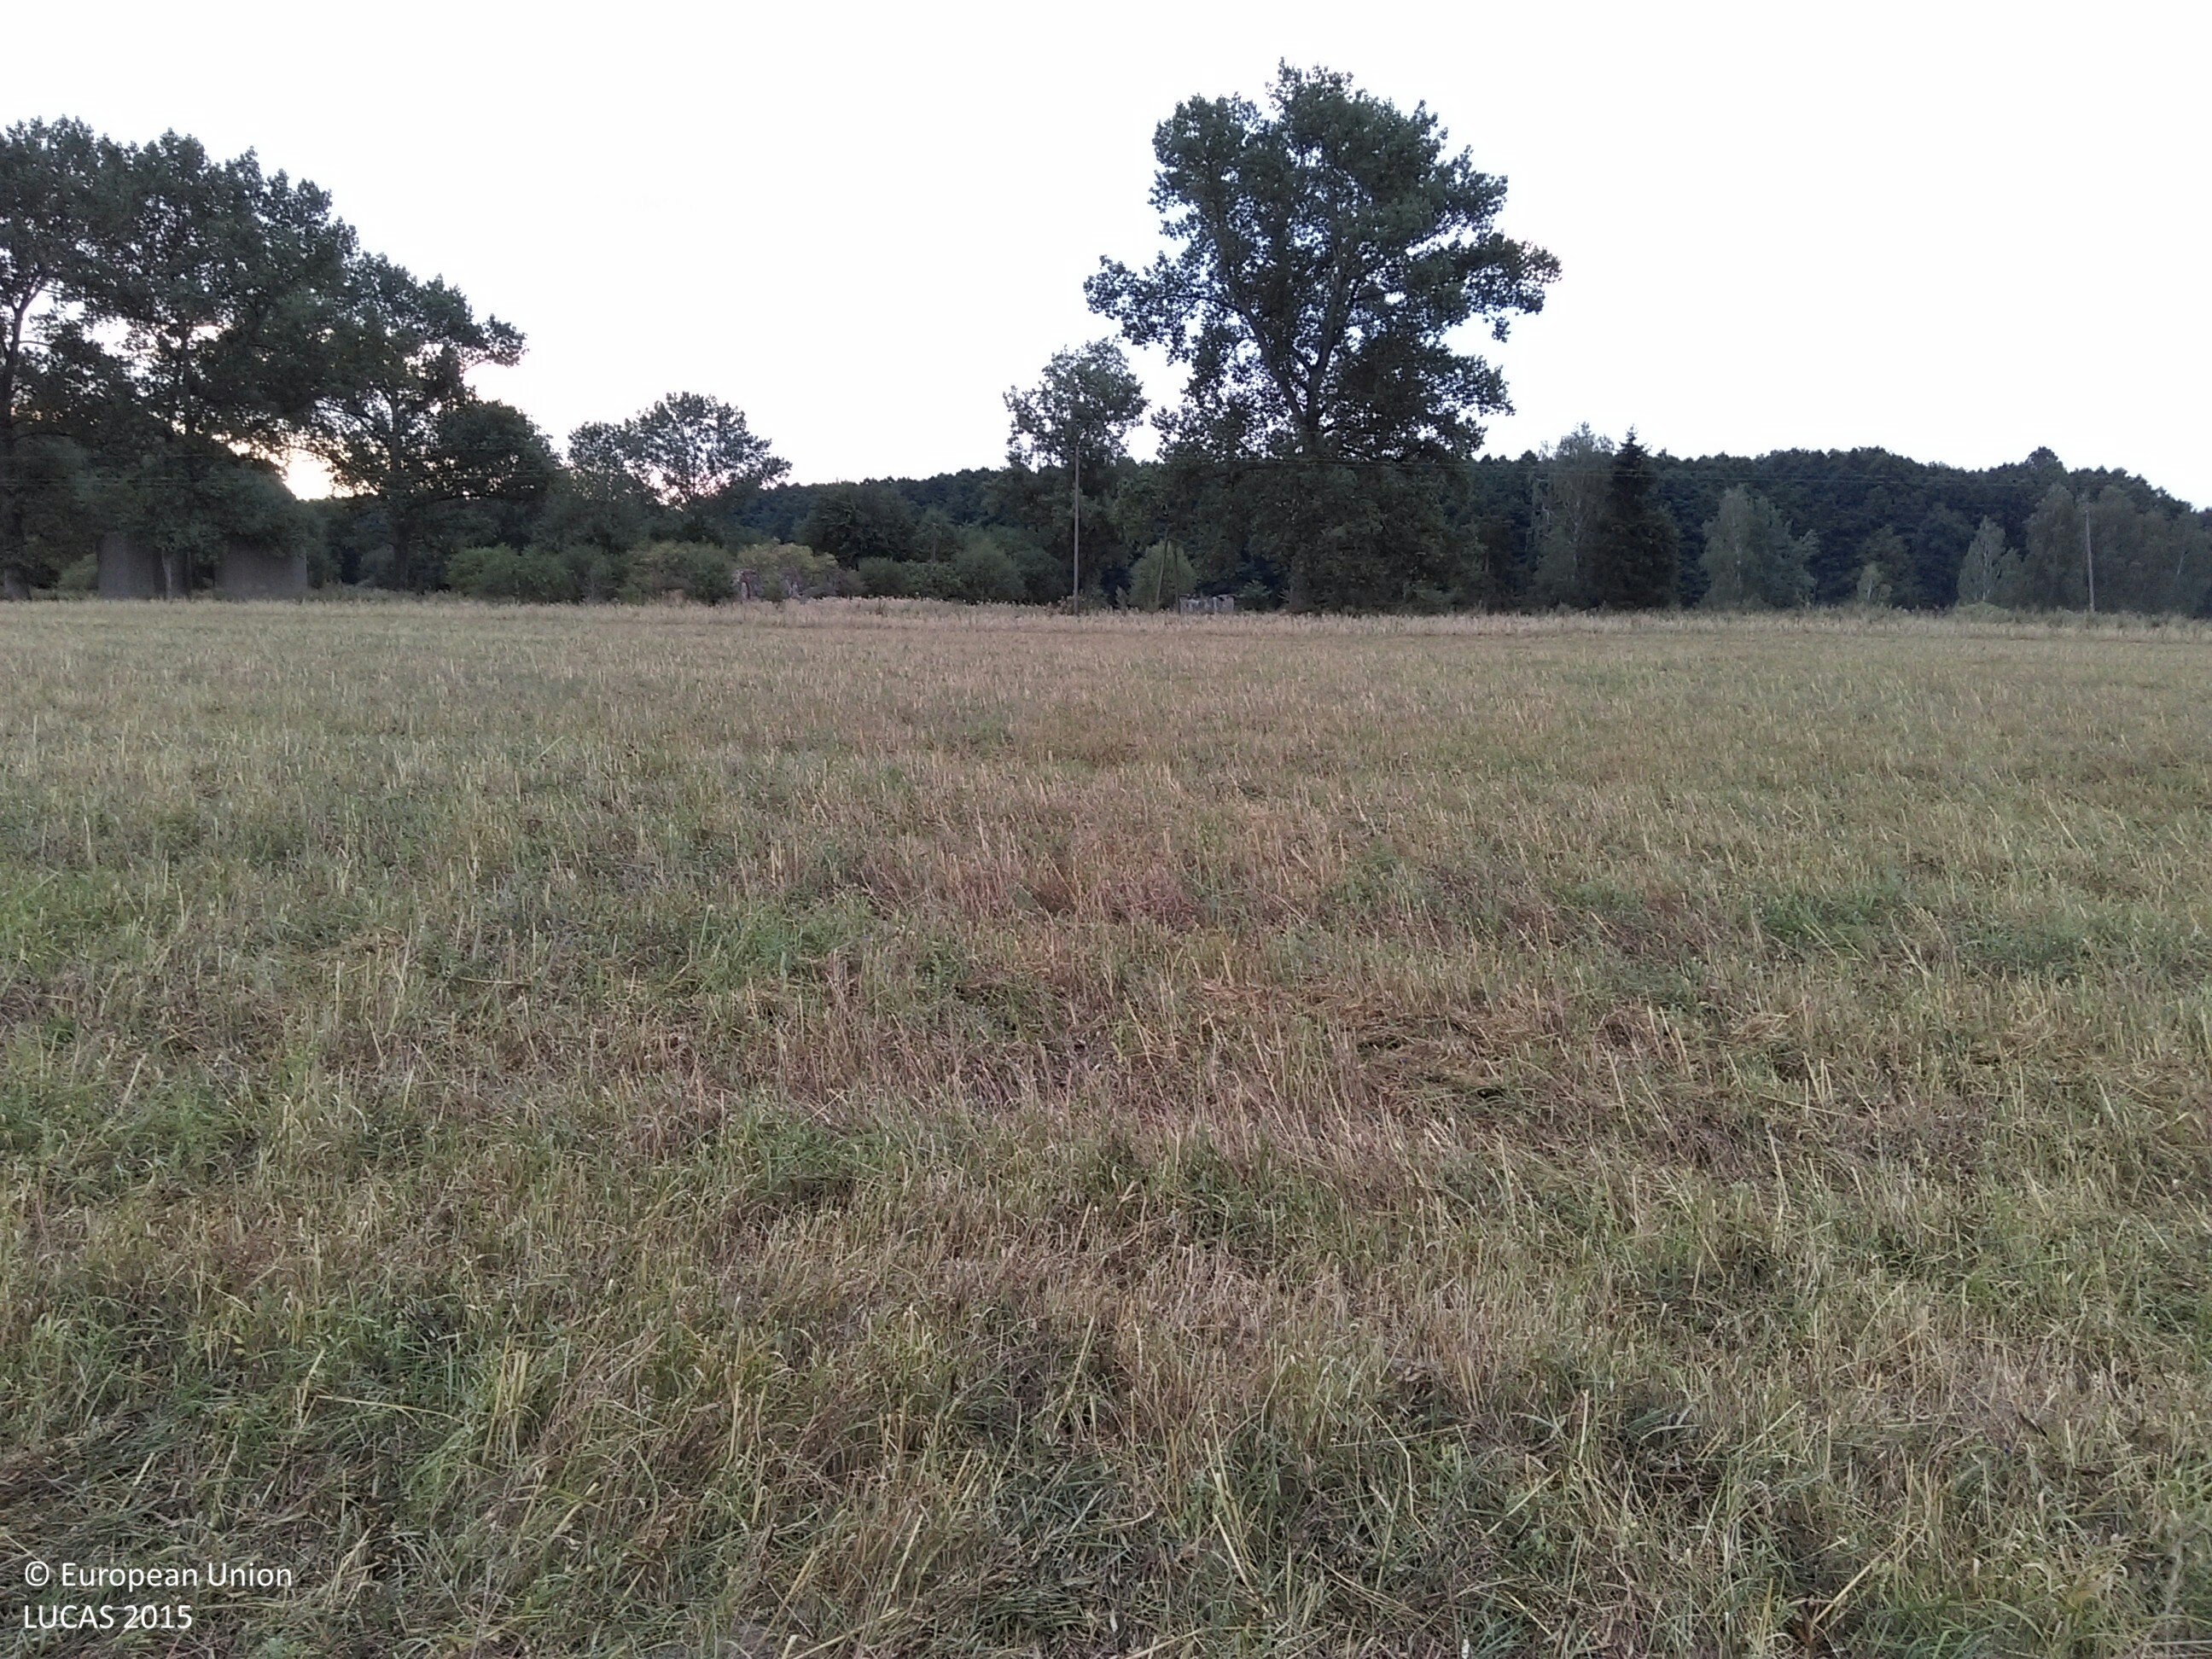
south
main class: Cropland
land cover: Oats
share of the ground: 50 - 75 %
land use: Agriculture (excluding fallow land and kitchen gardens)
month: August
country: PL
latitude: 52.1400
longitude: 15.5419
